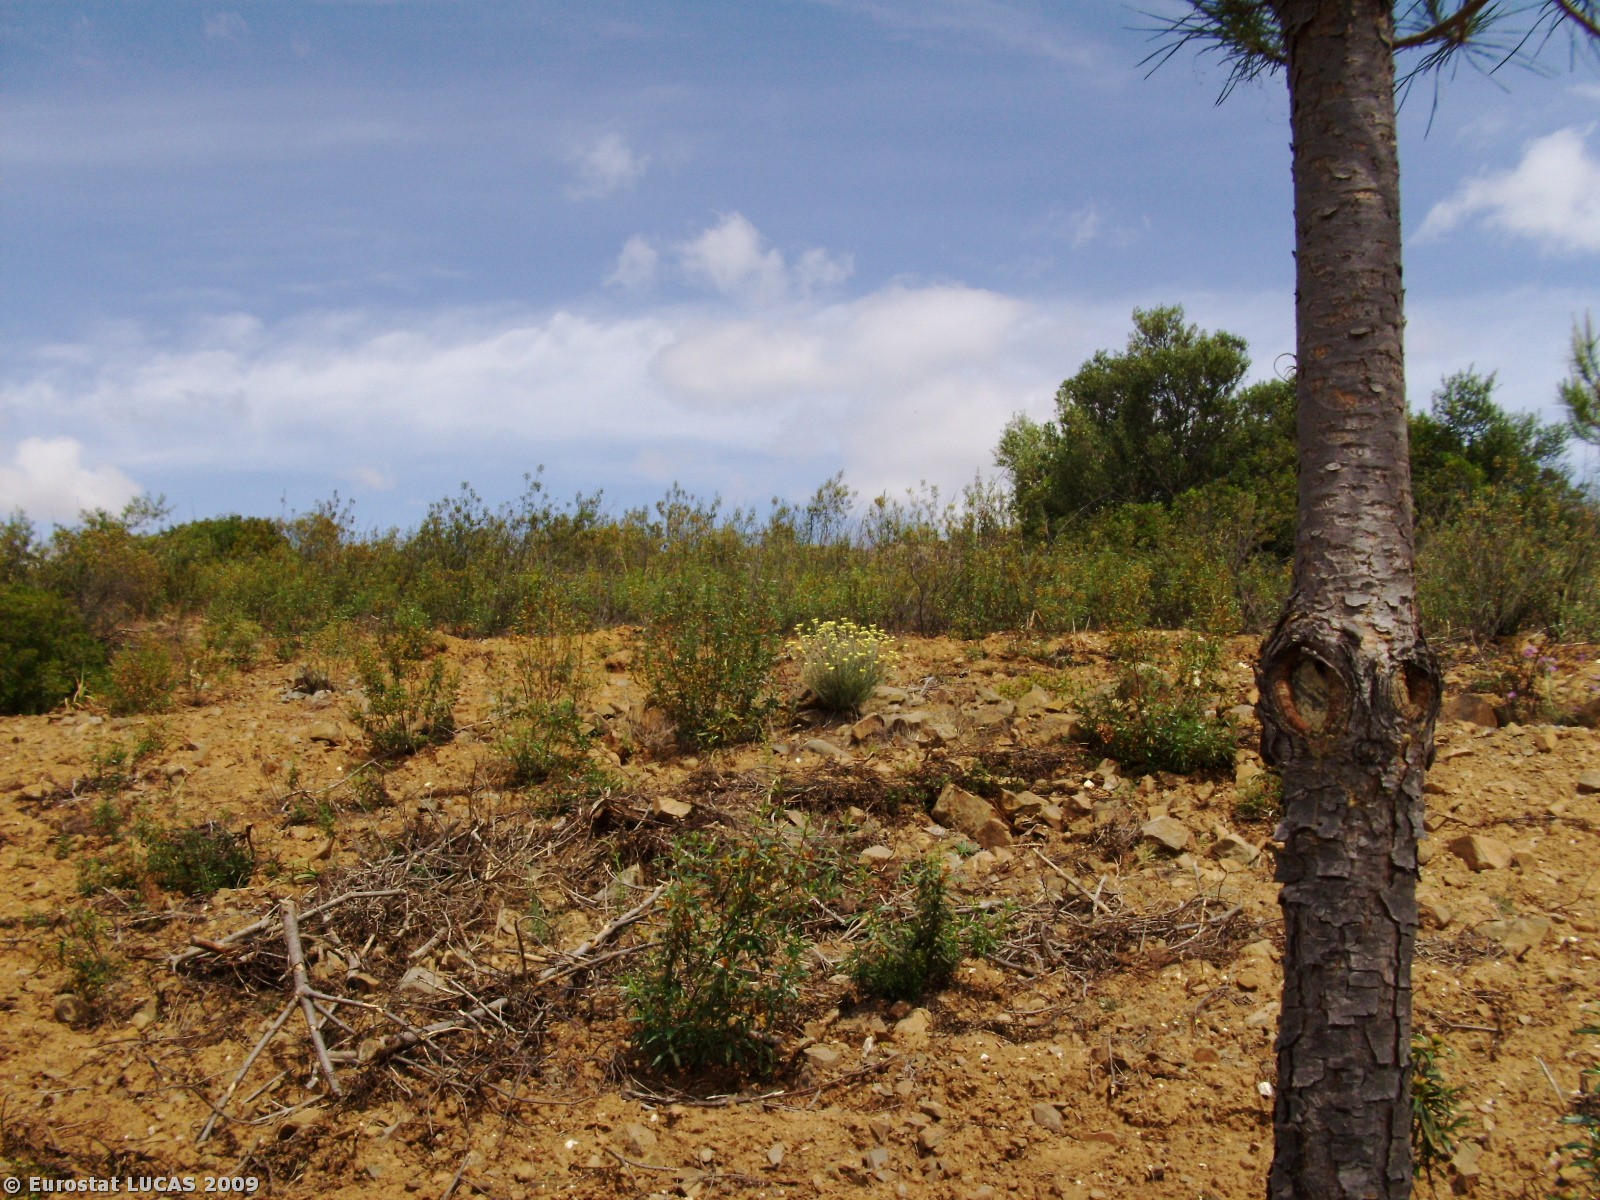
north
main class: Woodland
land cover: Coniferous woodland
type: coniferous forest of the mediterranean region
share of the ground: 25 - 50 %
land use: Forestry
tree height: > 5 m
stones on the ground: > 50 %
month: April
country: PT
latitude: 37.5869
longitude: -7.7162
